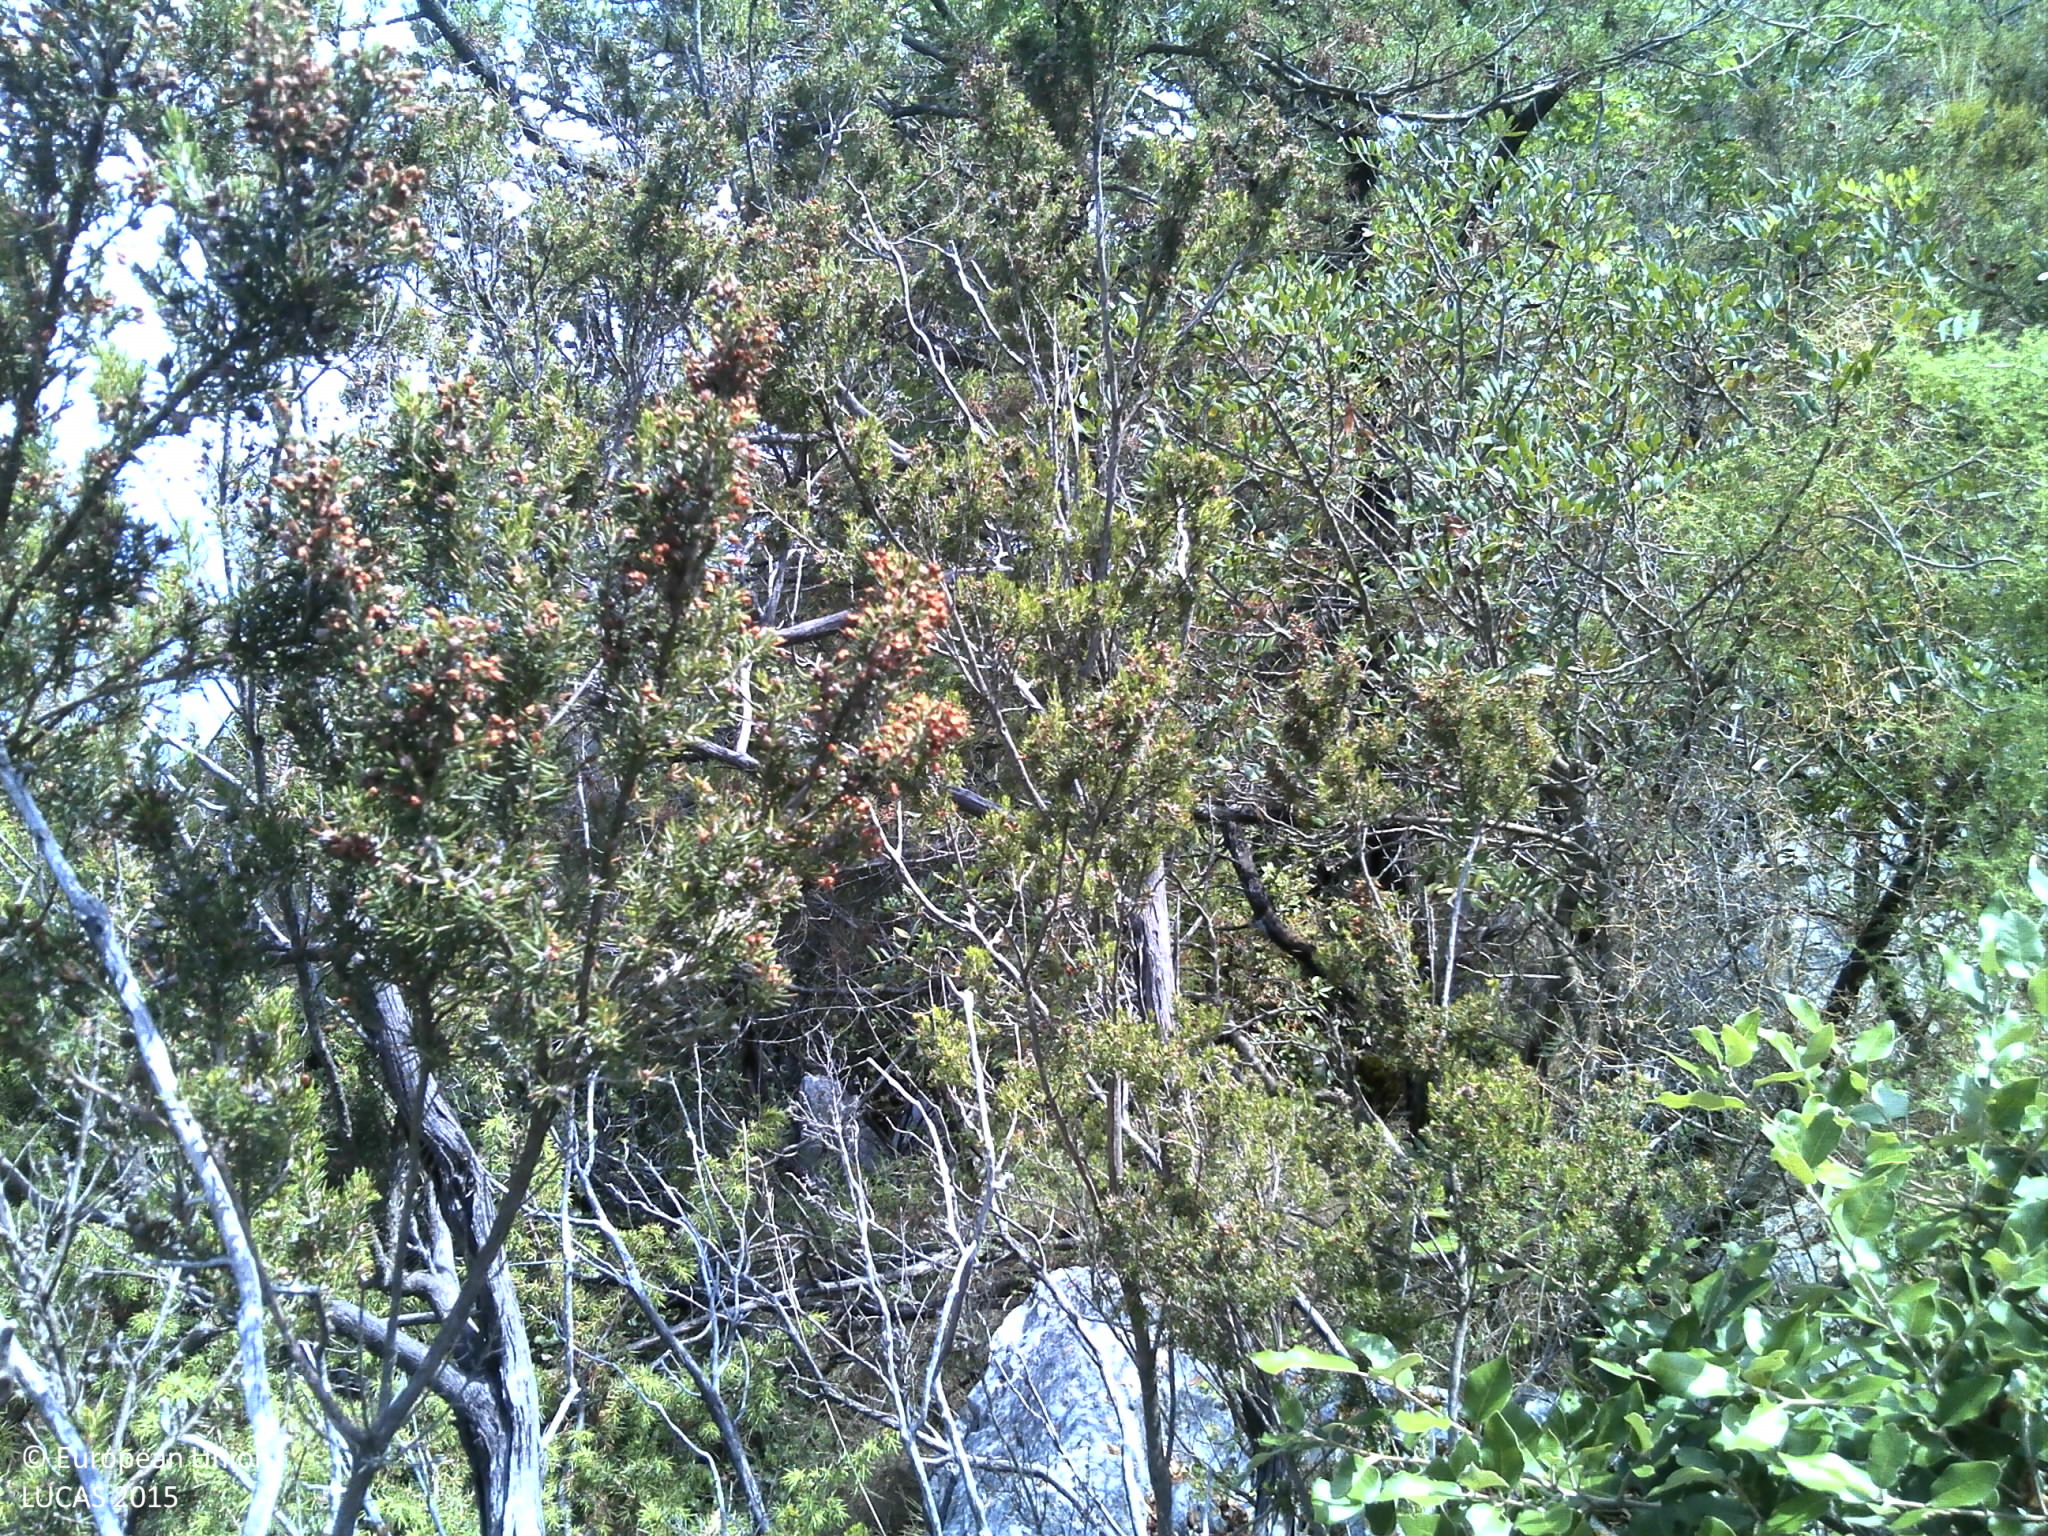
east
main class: Shrubland
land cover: Shrubland with sparse tree cover
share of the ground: > 75 %
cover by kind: shrubs 70 %, unconsolidated bare surface 10 %, broadleaved forest trees 5 %, herbaceous plants 5 %, lichens and mosses 5 %, consolidated bare surface 5 %
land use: Semi-natural and natural areas not in use
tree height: < 5 m
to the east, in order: Shrubland with sparse tree cover; Rock outcrops; Shrubland with sparse tree cover; Dry stone walls; Shrubland with sparse tree cover
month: August
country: HR
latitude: 43.1357
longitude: 17.0098
